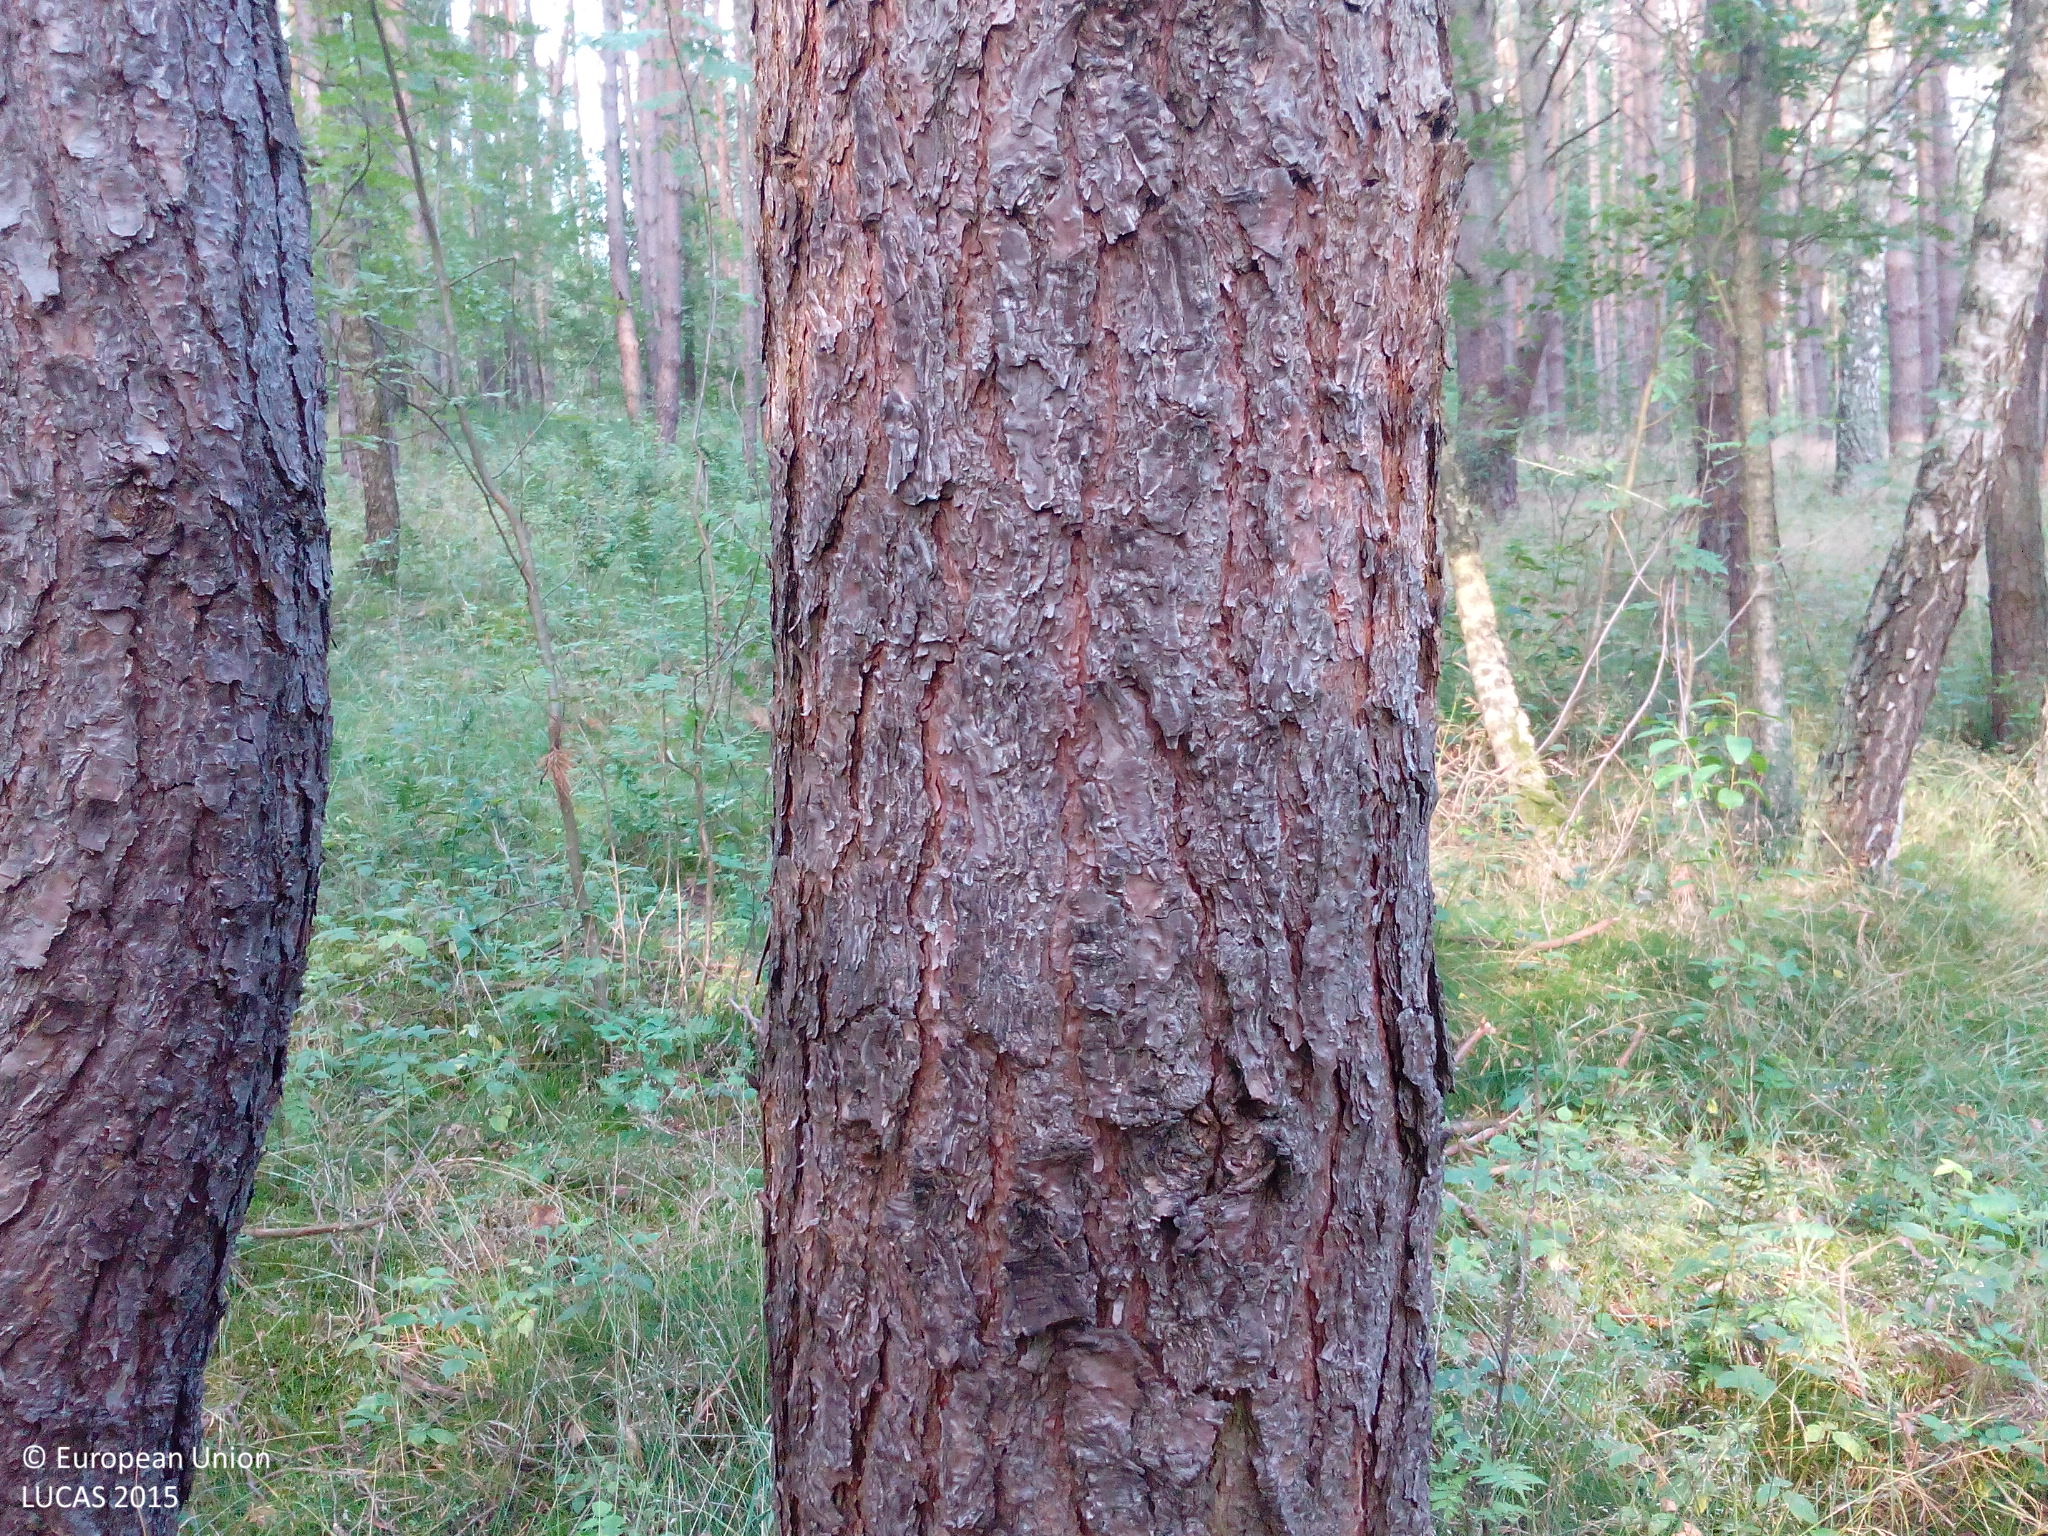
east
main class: Woodland
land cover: Pine dominated mixed woodland
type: hemiboreal forest and nemoral coniferous forest and mixed broadleaved-coniferous forest
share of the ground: 50 - 75 %
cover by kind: coniferous forest trees 45 %, broadleaved forest trees 25 %, shrubs 15 %, herbaceous plants 15 %
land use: Forestry
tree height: > 5 m
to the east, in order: Pine dominated mixed woodland; Tracks; Pine dominated coniferous woodland; Pine dominated mixed woodland; Broadleaved woodland; Spruce dominated coniferous woodland; Spruce dominated mixed woodland
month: July
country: DE
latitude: 53.4878
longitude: 14.2960
